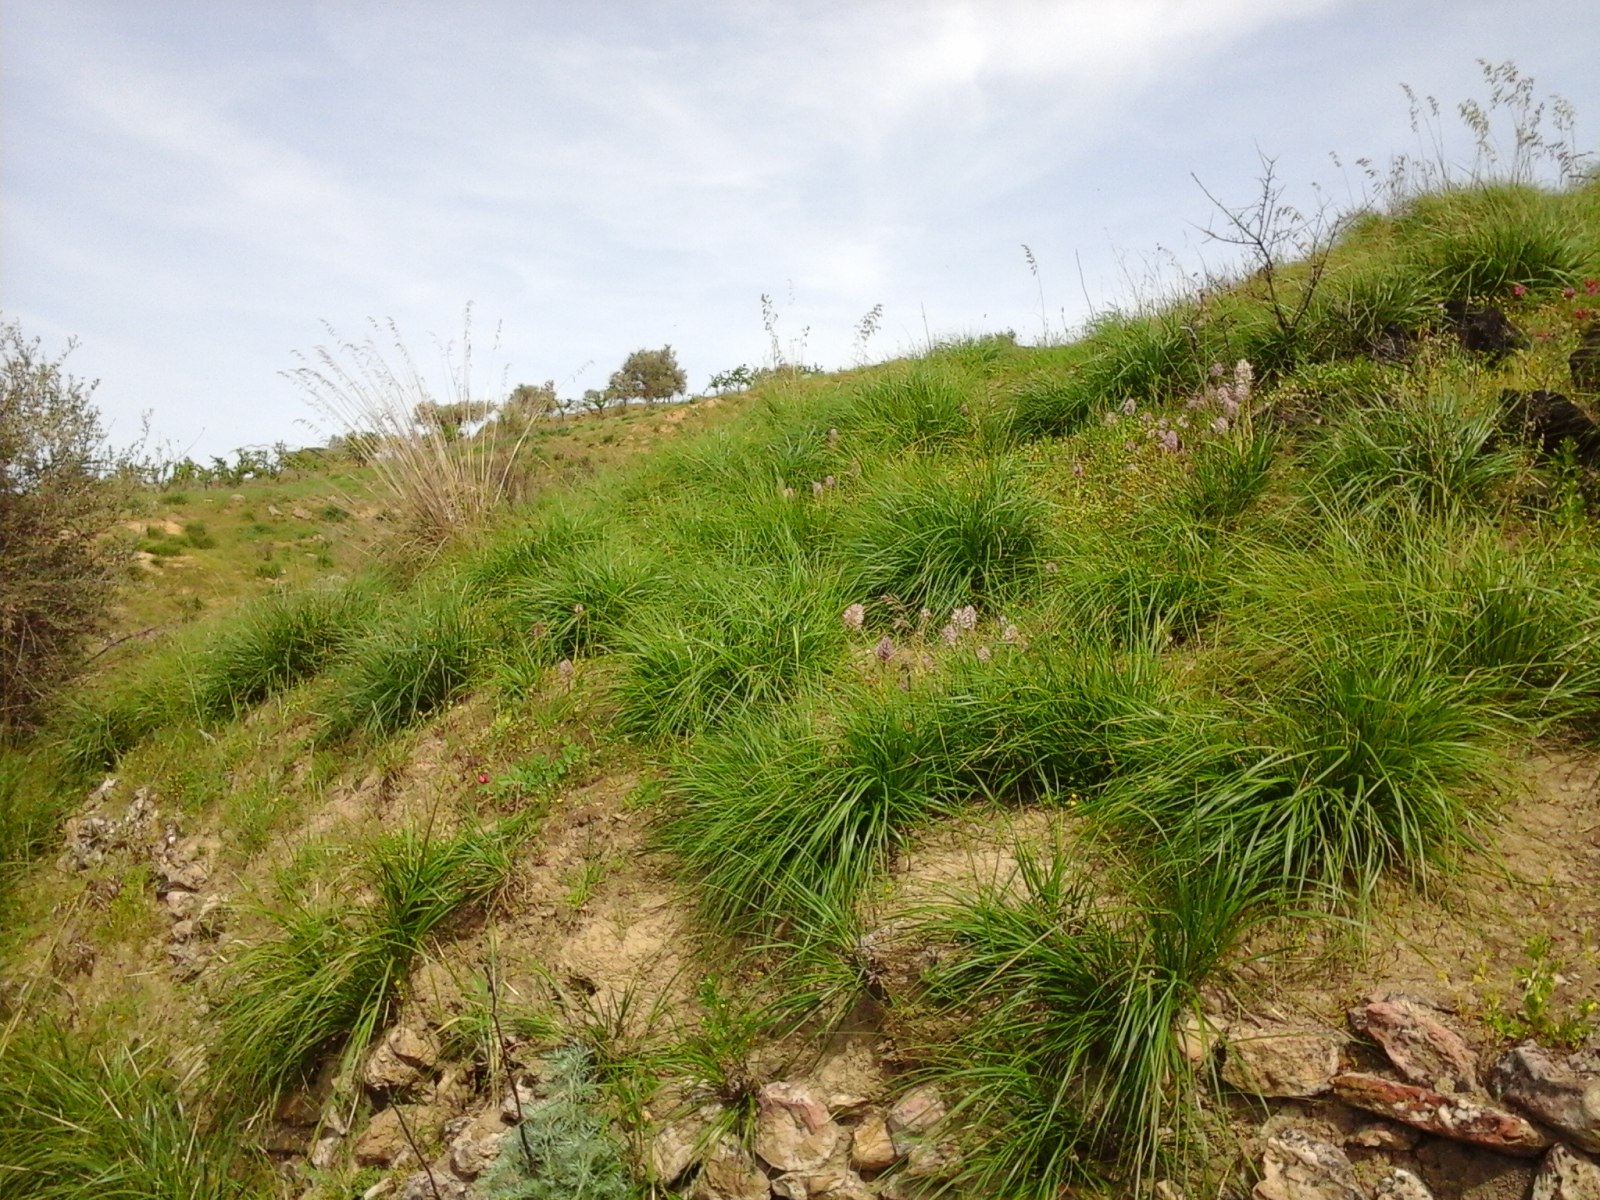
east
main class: Grassland
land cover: Grassland with sparse tree/shrub cover
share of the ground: 50 - 75 %
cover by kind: herbaceous plants 90 %, broadleaved forest trees 5 %, shrubs 5 %
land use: Agriculture (excluding fallow land and kitchen gardens)
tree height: < 5 m
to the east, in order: Grassland with sparse tree/shrub cover; Olive groves; Grassland without tree/shrub cover; Ditches and canals; Grassland without tree/shrub cover; Other bare soil; Nuts trees; Fences; Olive groves; Other bare soil; Fences; Paved roads, cycling and walking lanes; Grass margins; Spontaneously vegetated surfaces
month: May
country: IT
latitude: 37.3829
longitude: 14.1810
